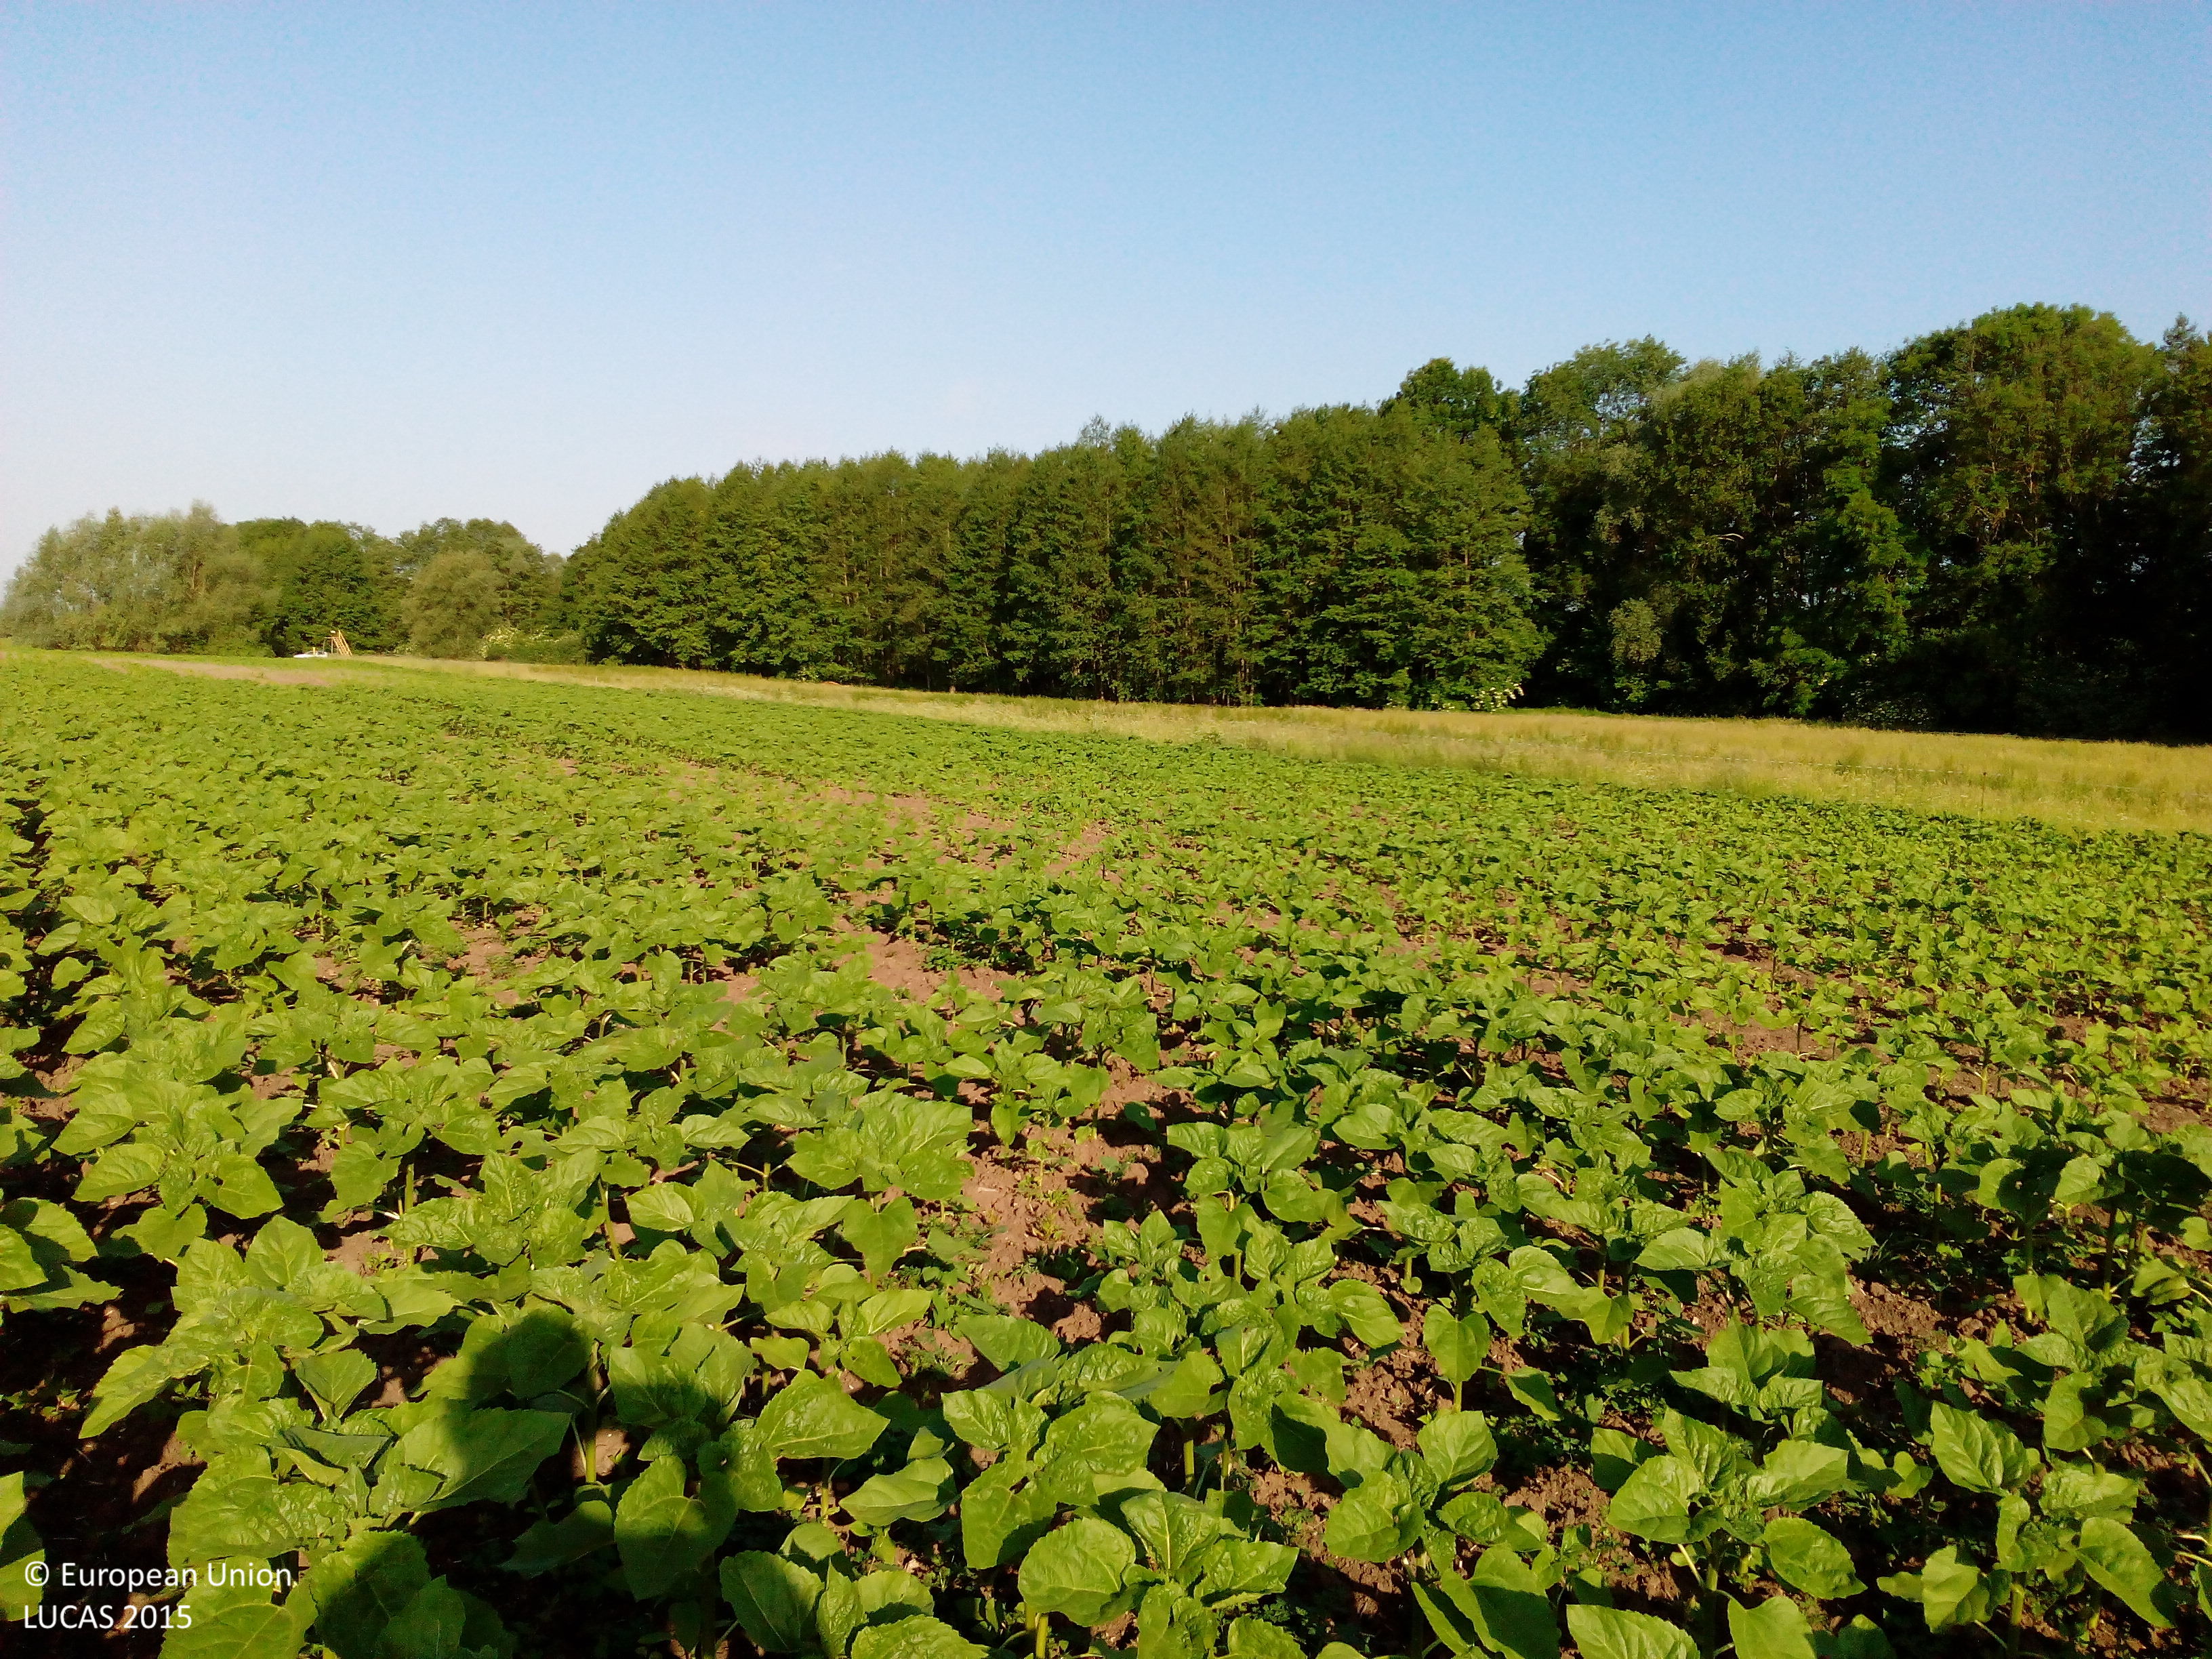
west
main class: Cropland
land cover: Sunflower
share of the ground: > 75 %
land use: Agriculture (excluding fallow land and kitchen gardens)
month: June
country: DE
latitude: 51.1641
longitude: 11.4440
